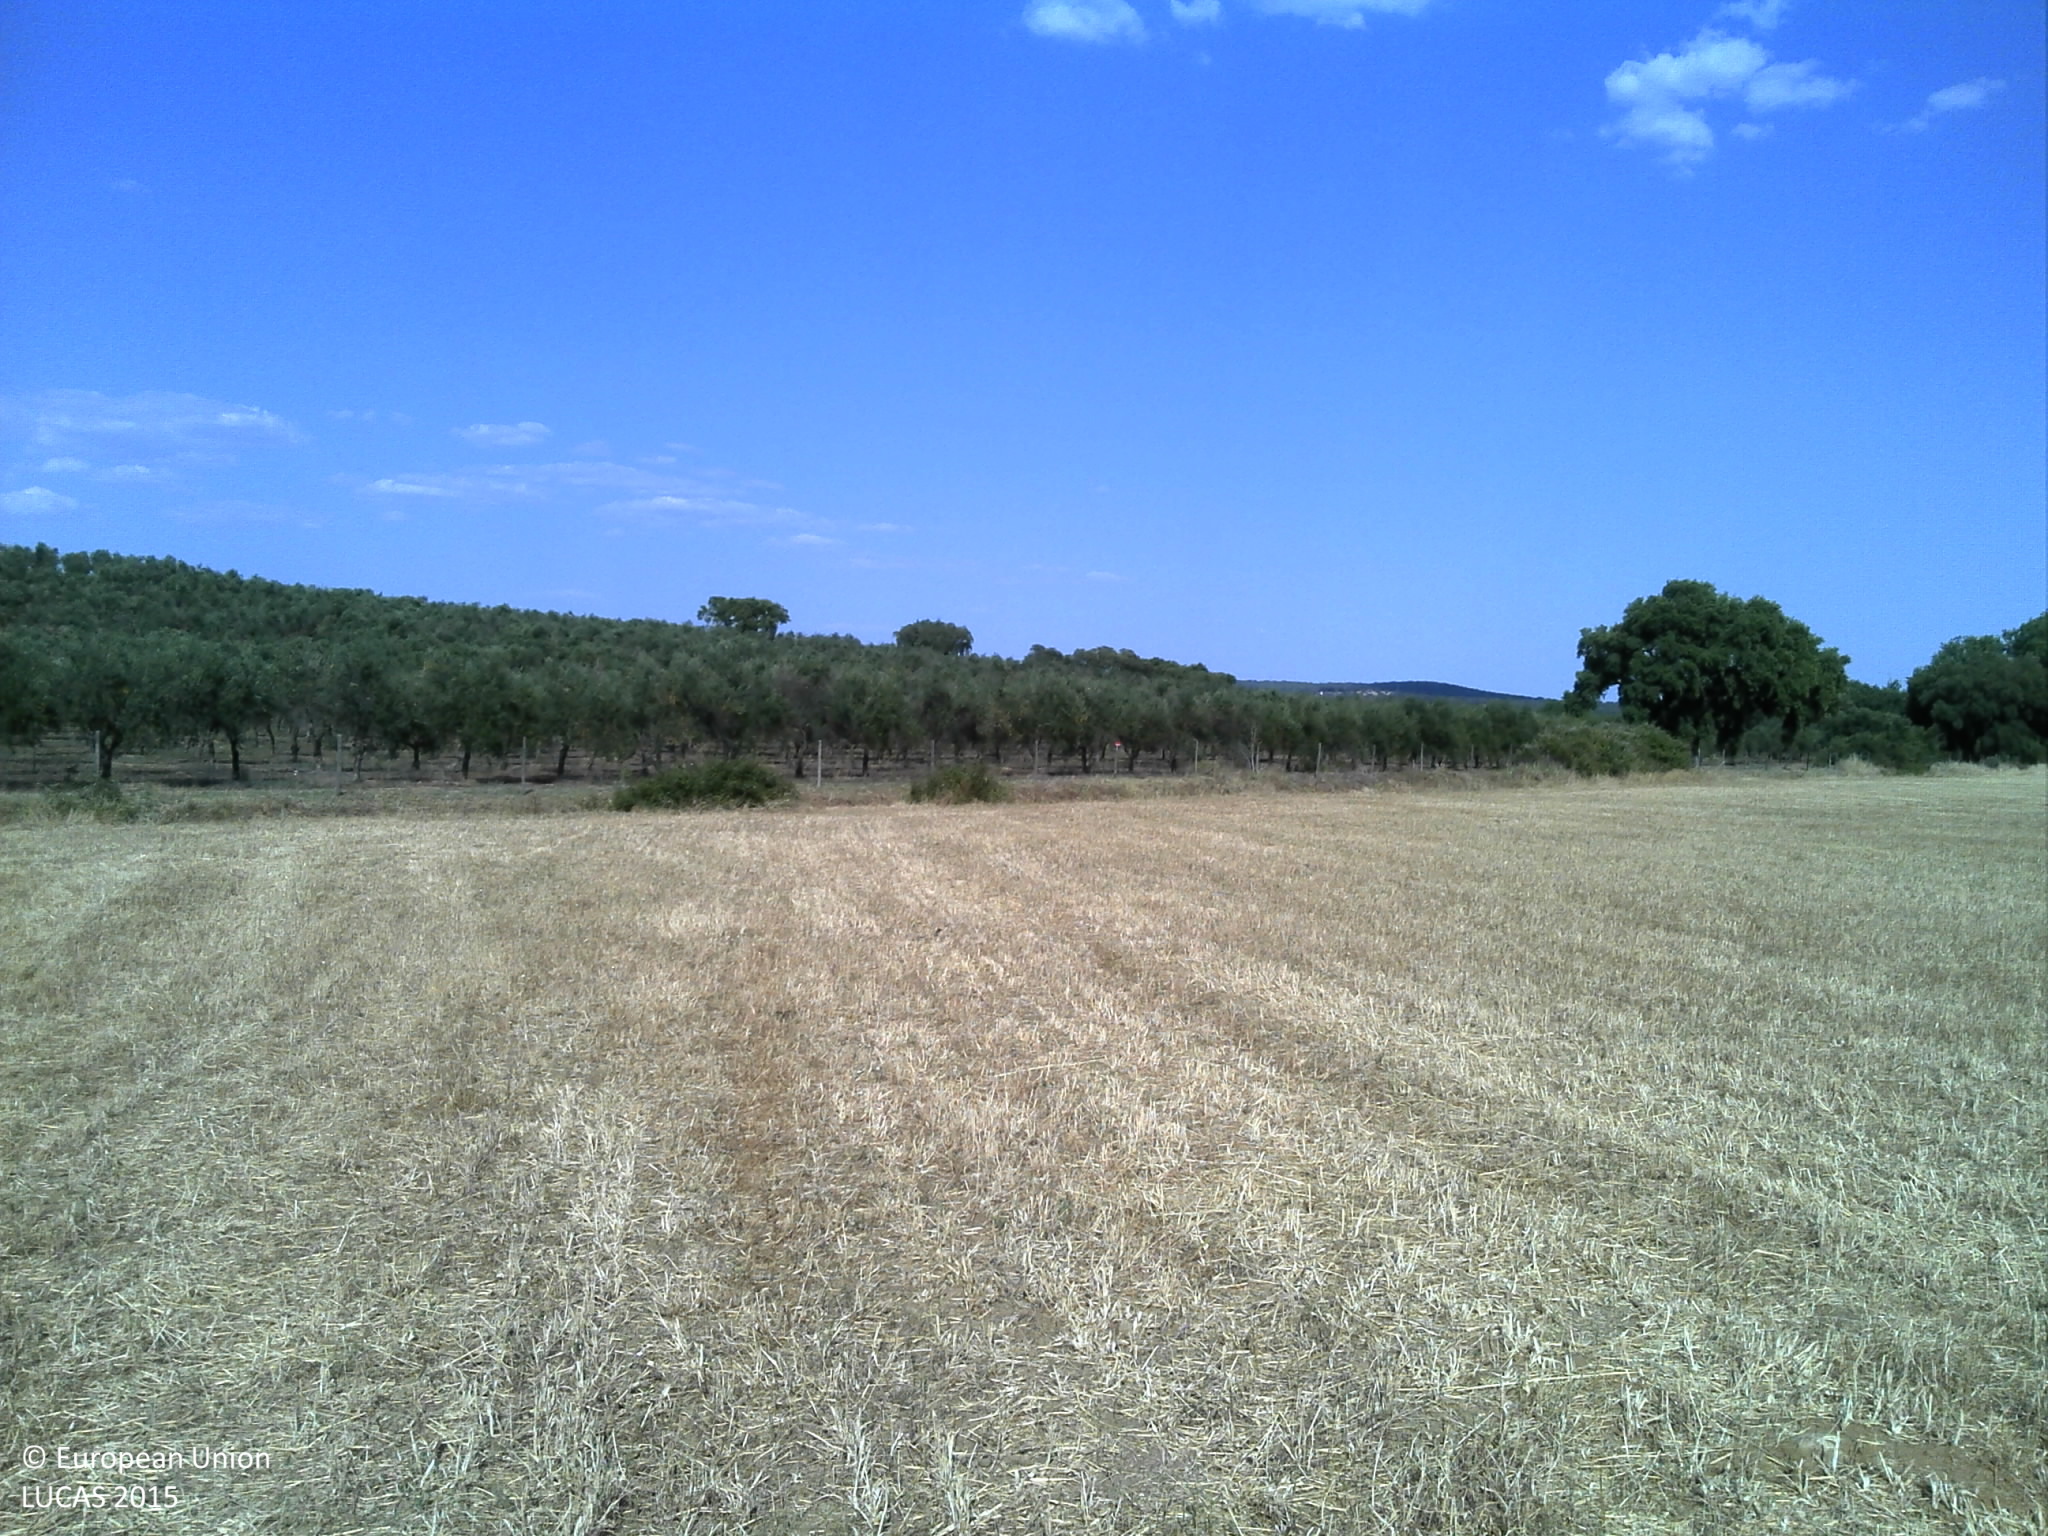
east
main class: Cropland
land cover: Oats
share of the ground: < 10 %
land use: Agriculture (excluding fallow land and kitchen gardens)
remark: Harvested field
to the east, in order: Oats; Rivers and streams; Grass margins; Fences; Other bare soil; Olive groves
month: June
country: PT
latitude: 38.6895
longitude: -7.8485
